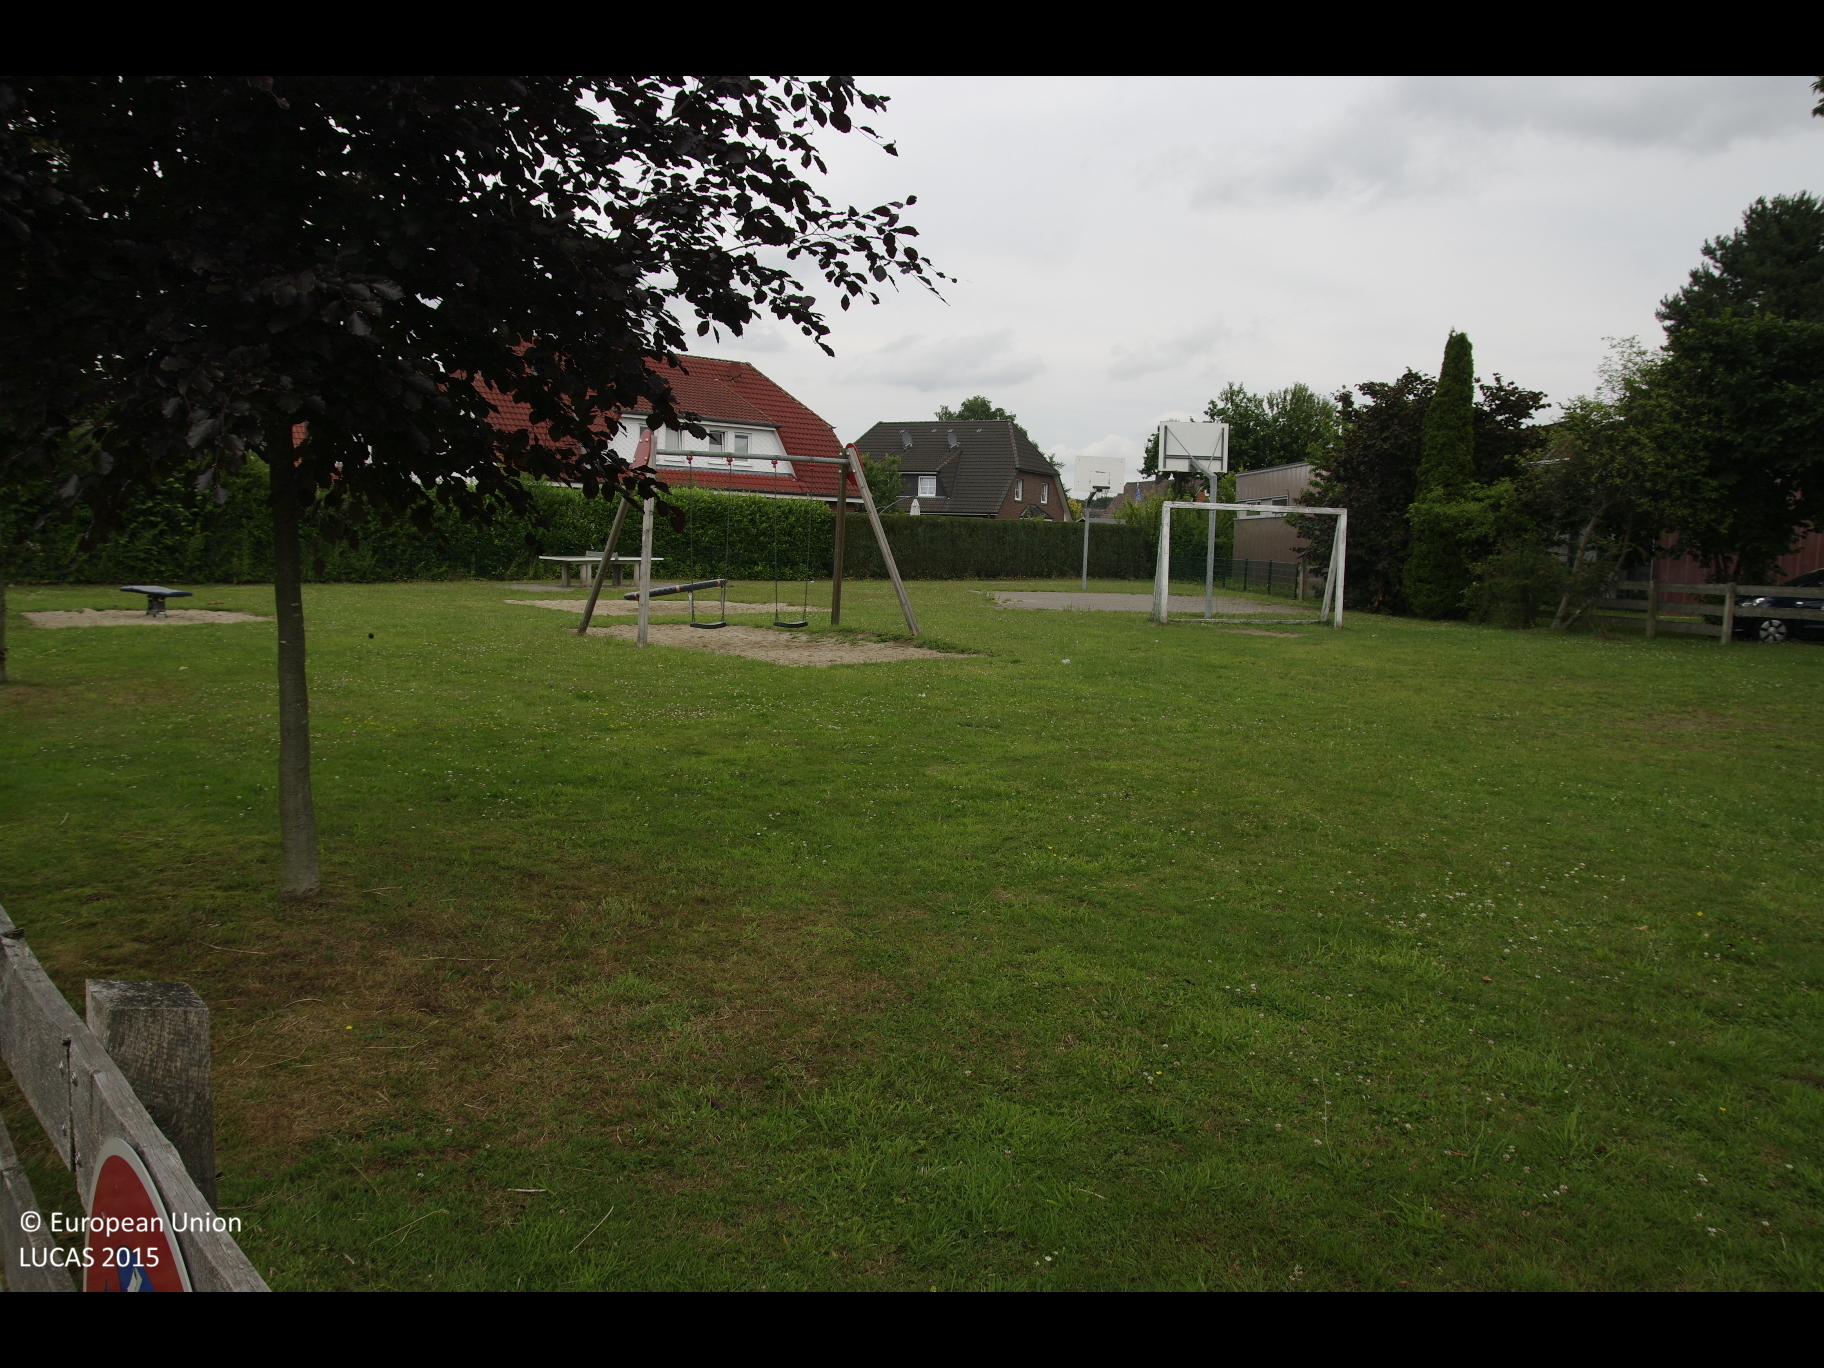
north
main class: Grassland
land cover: Grassland without tree/shrub cover
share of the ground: > 75 %
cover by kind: herbaceous plants 100 %
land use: Residential
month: July
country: DE
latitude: 53.4914
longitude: 10.3164
